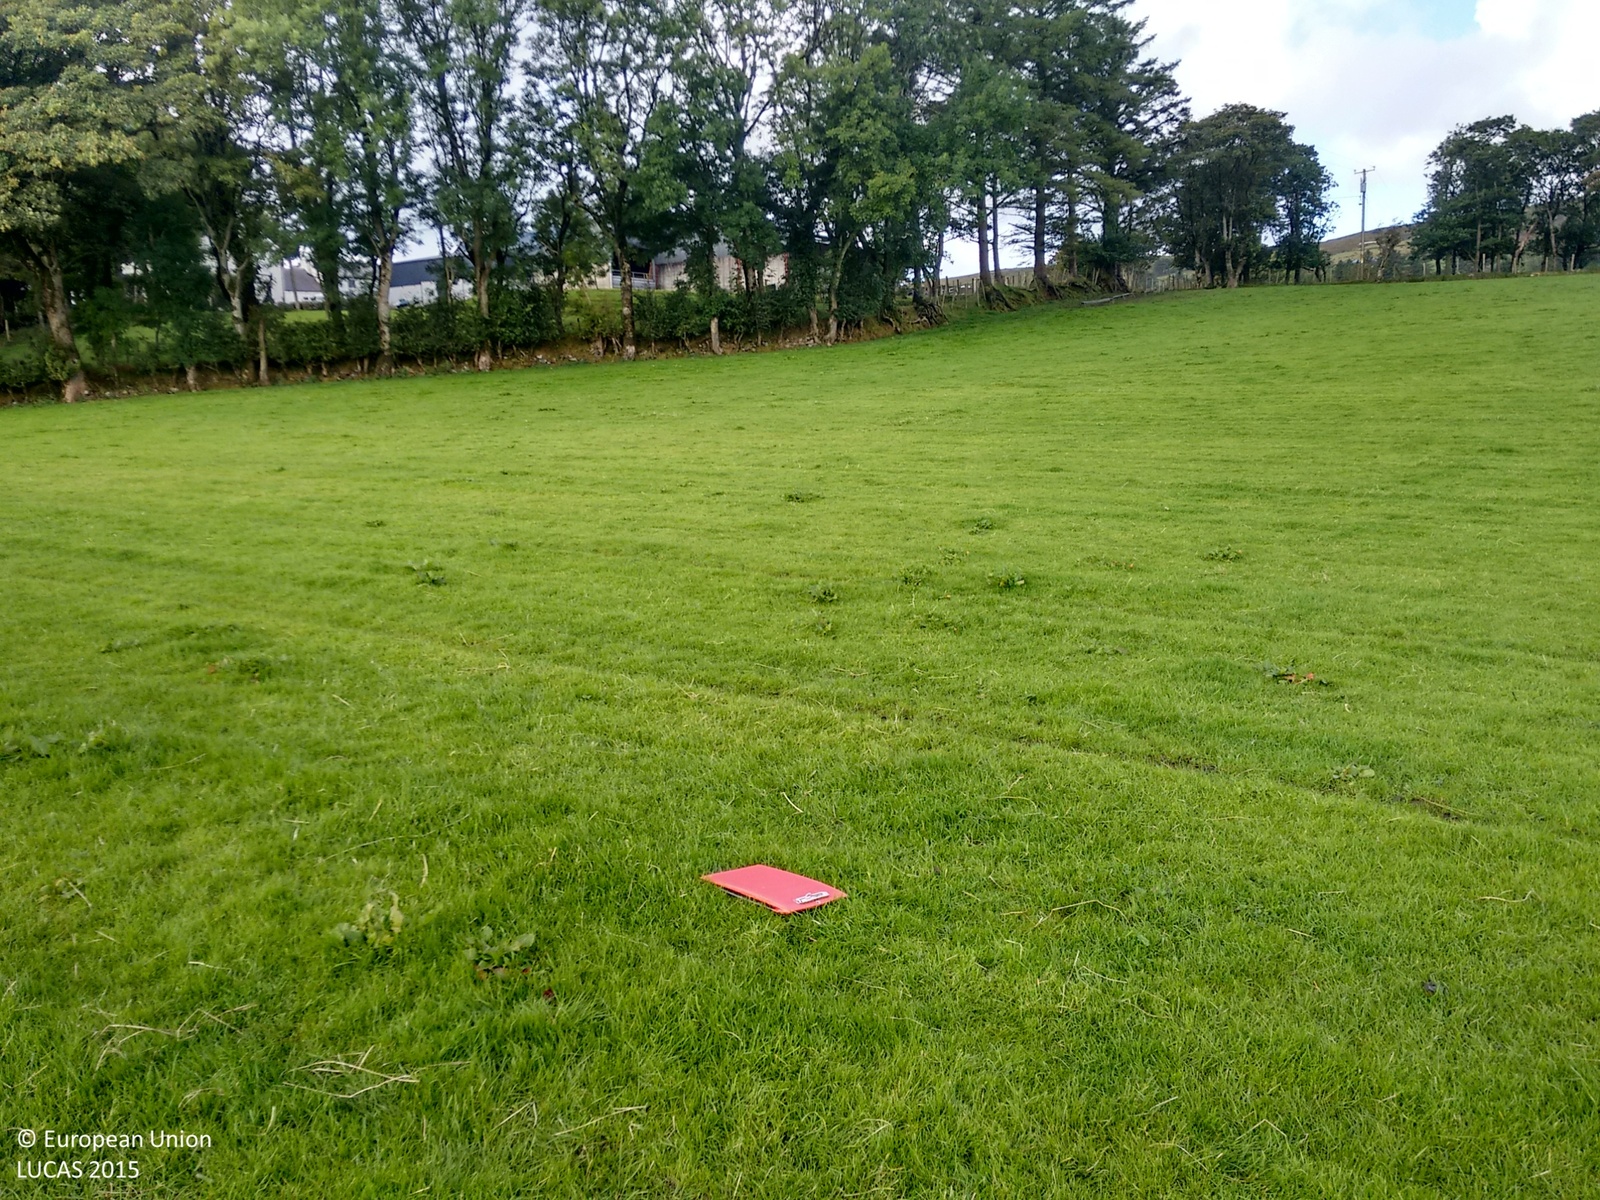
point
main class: Grassland
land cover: Grassland without tree/shrub cover
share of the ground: > 75 %
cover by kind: herbaceous plants 100 %
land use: Agriculture (excluding fallow land and kitchen gardens)
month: September
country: IE
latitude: 55.1859
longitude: -7.4111
